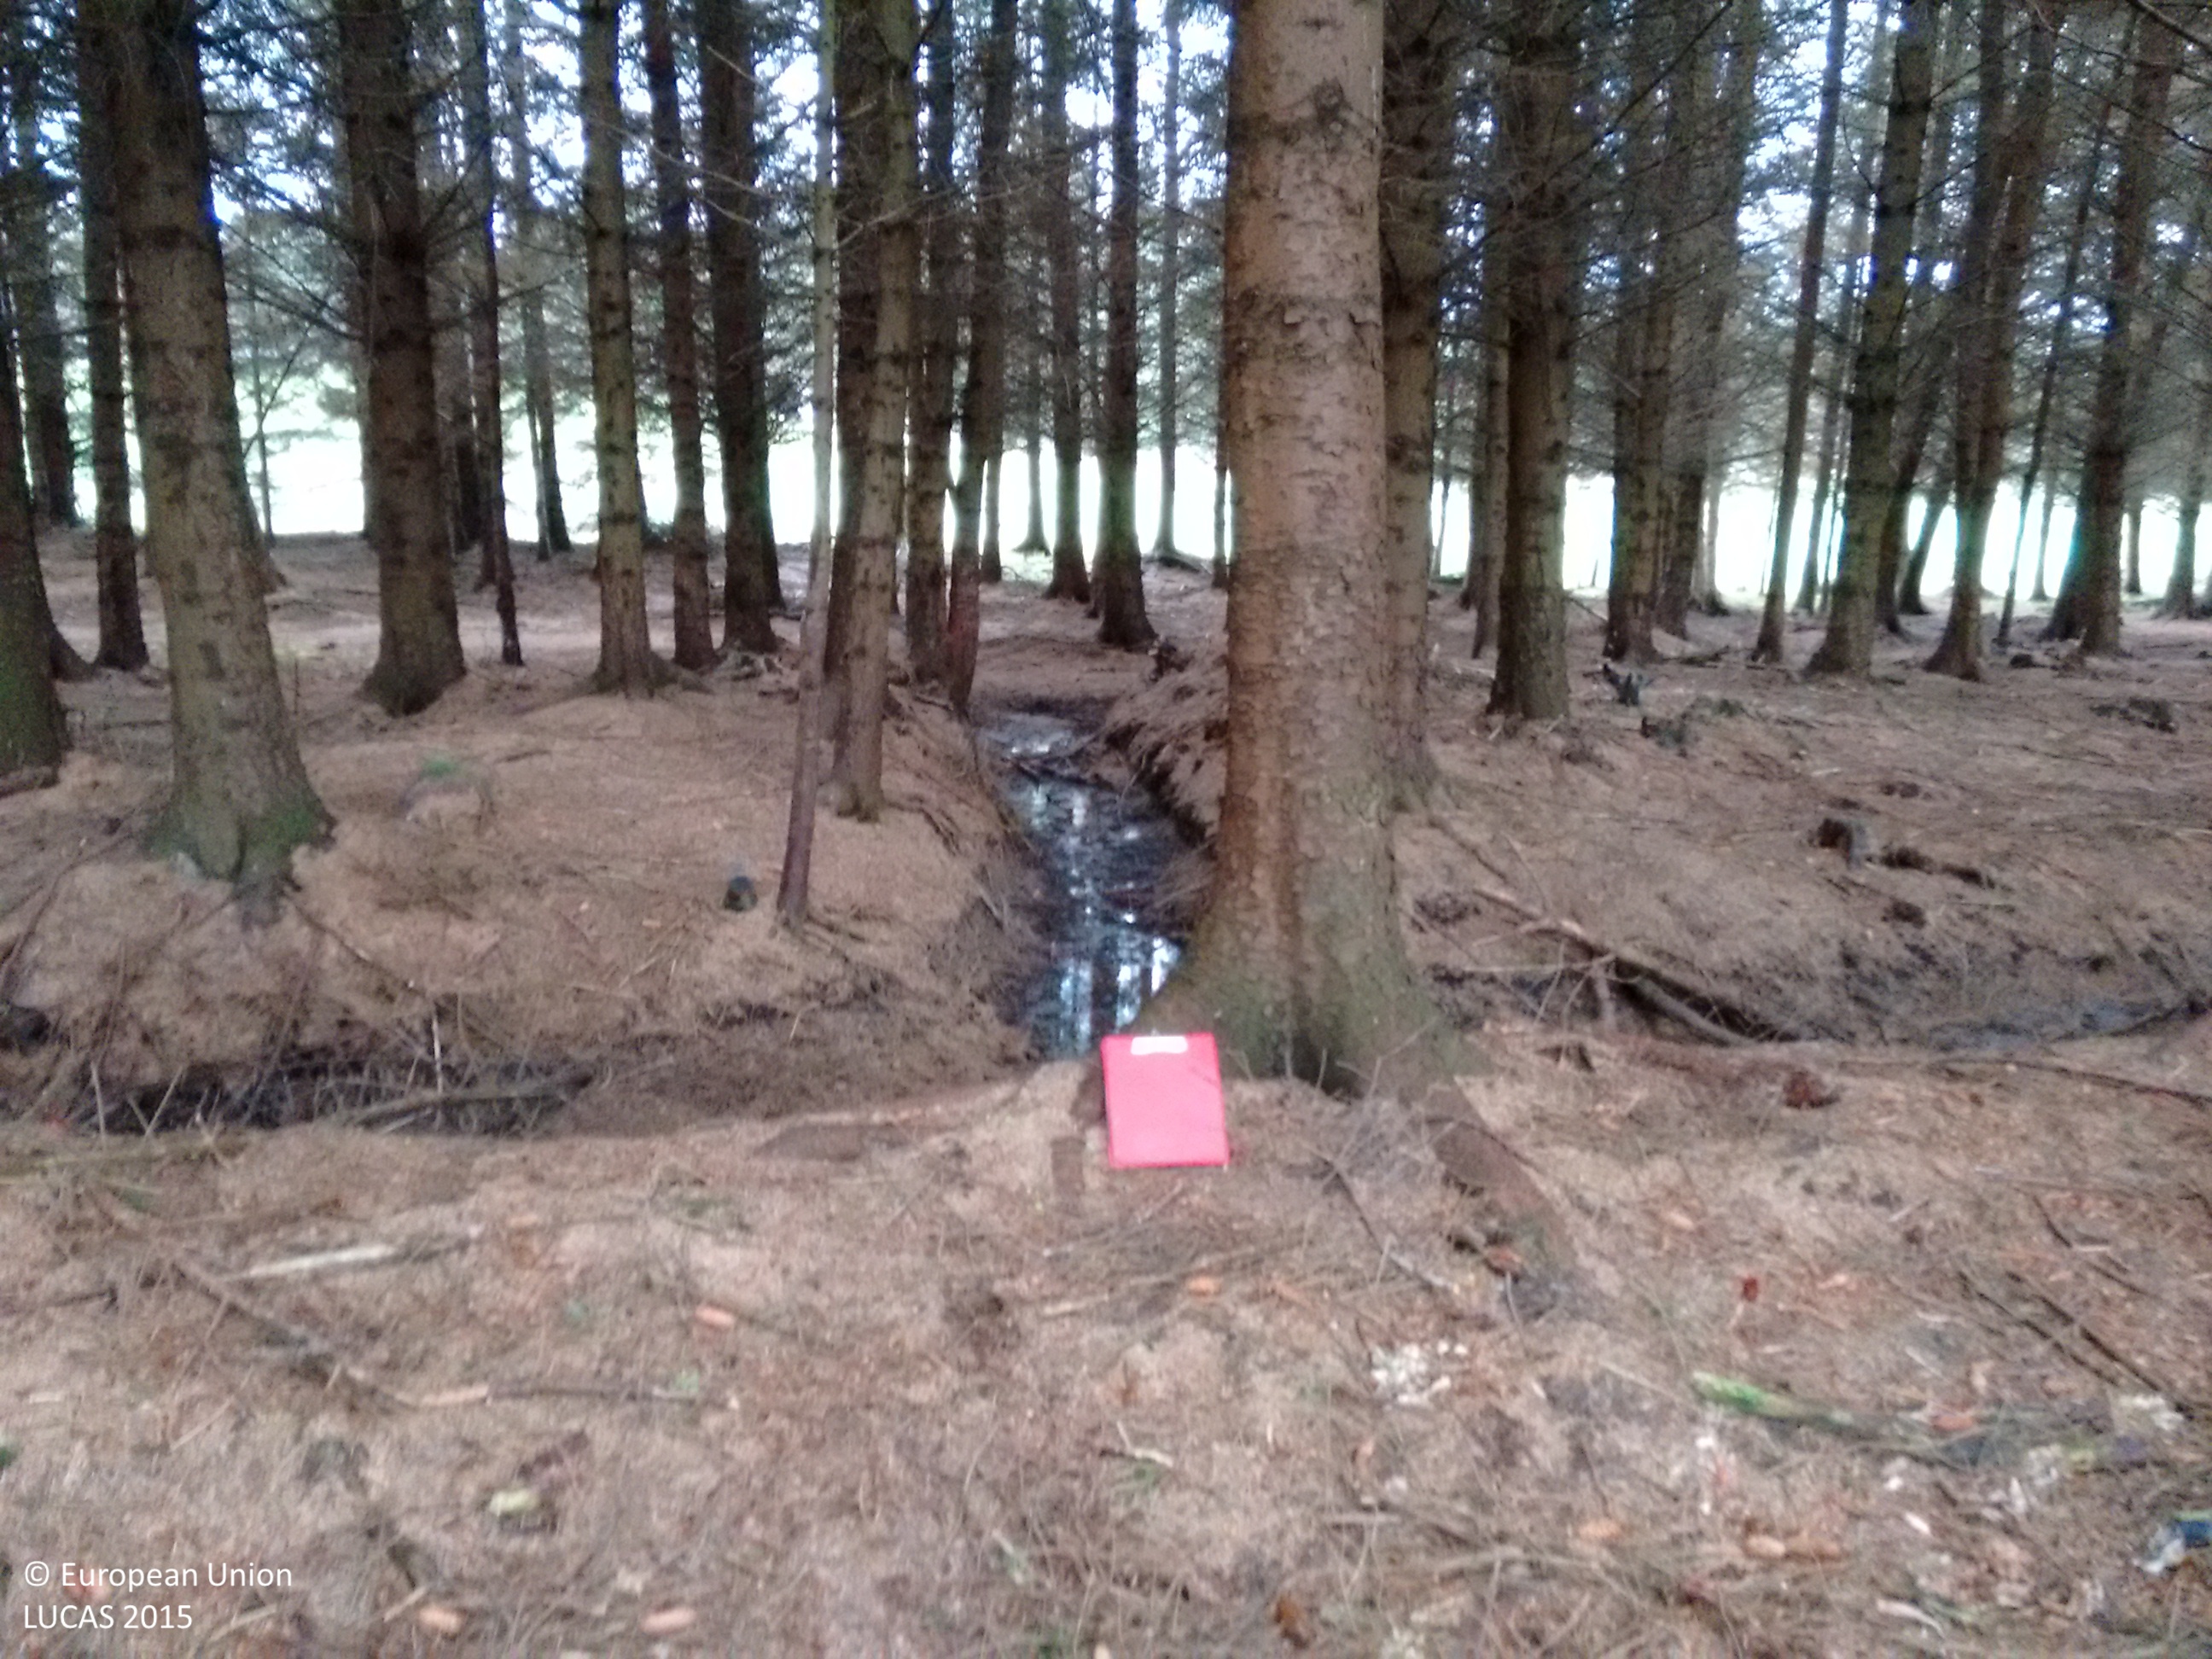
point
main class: Woodland
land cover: Spruce dominated coniferous woodland
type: exotic forest
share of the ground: > 75 %
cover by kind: coniferous forest trees 95 %, unconsolidated bare surface 5 %
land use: Forestry
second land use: Amenities, museums, leisure
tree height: > 5 m
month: May
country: GB
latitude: 55.8259
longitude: -3.2424
